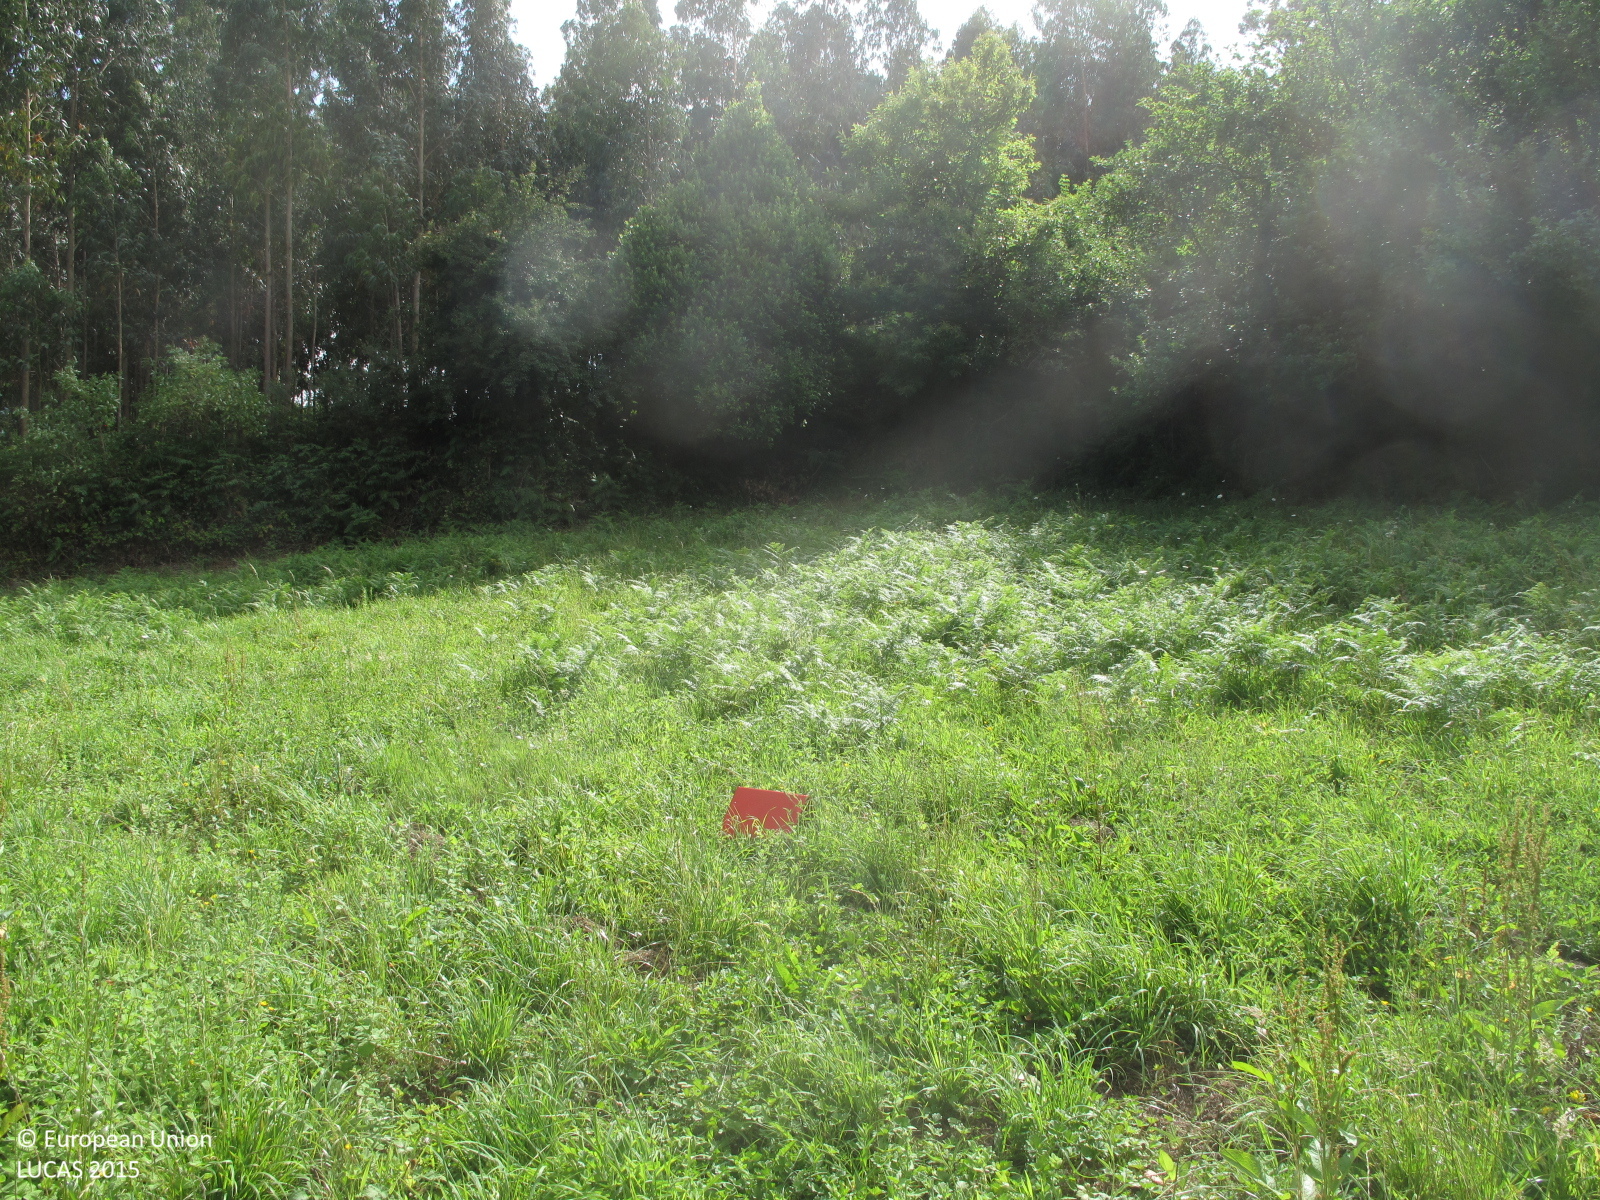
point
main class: Grassland
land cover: Grassland without tree/shrub cover
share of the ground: > 75 %
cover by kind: herbaceous plants 100 %
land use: Agriculture (excluding fallow land and kitchen gardens)
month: July
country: ES
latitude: 43.6744
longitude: -8.0471
